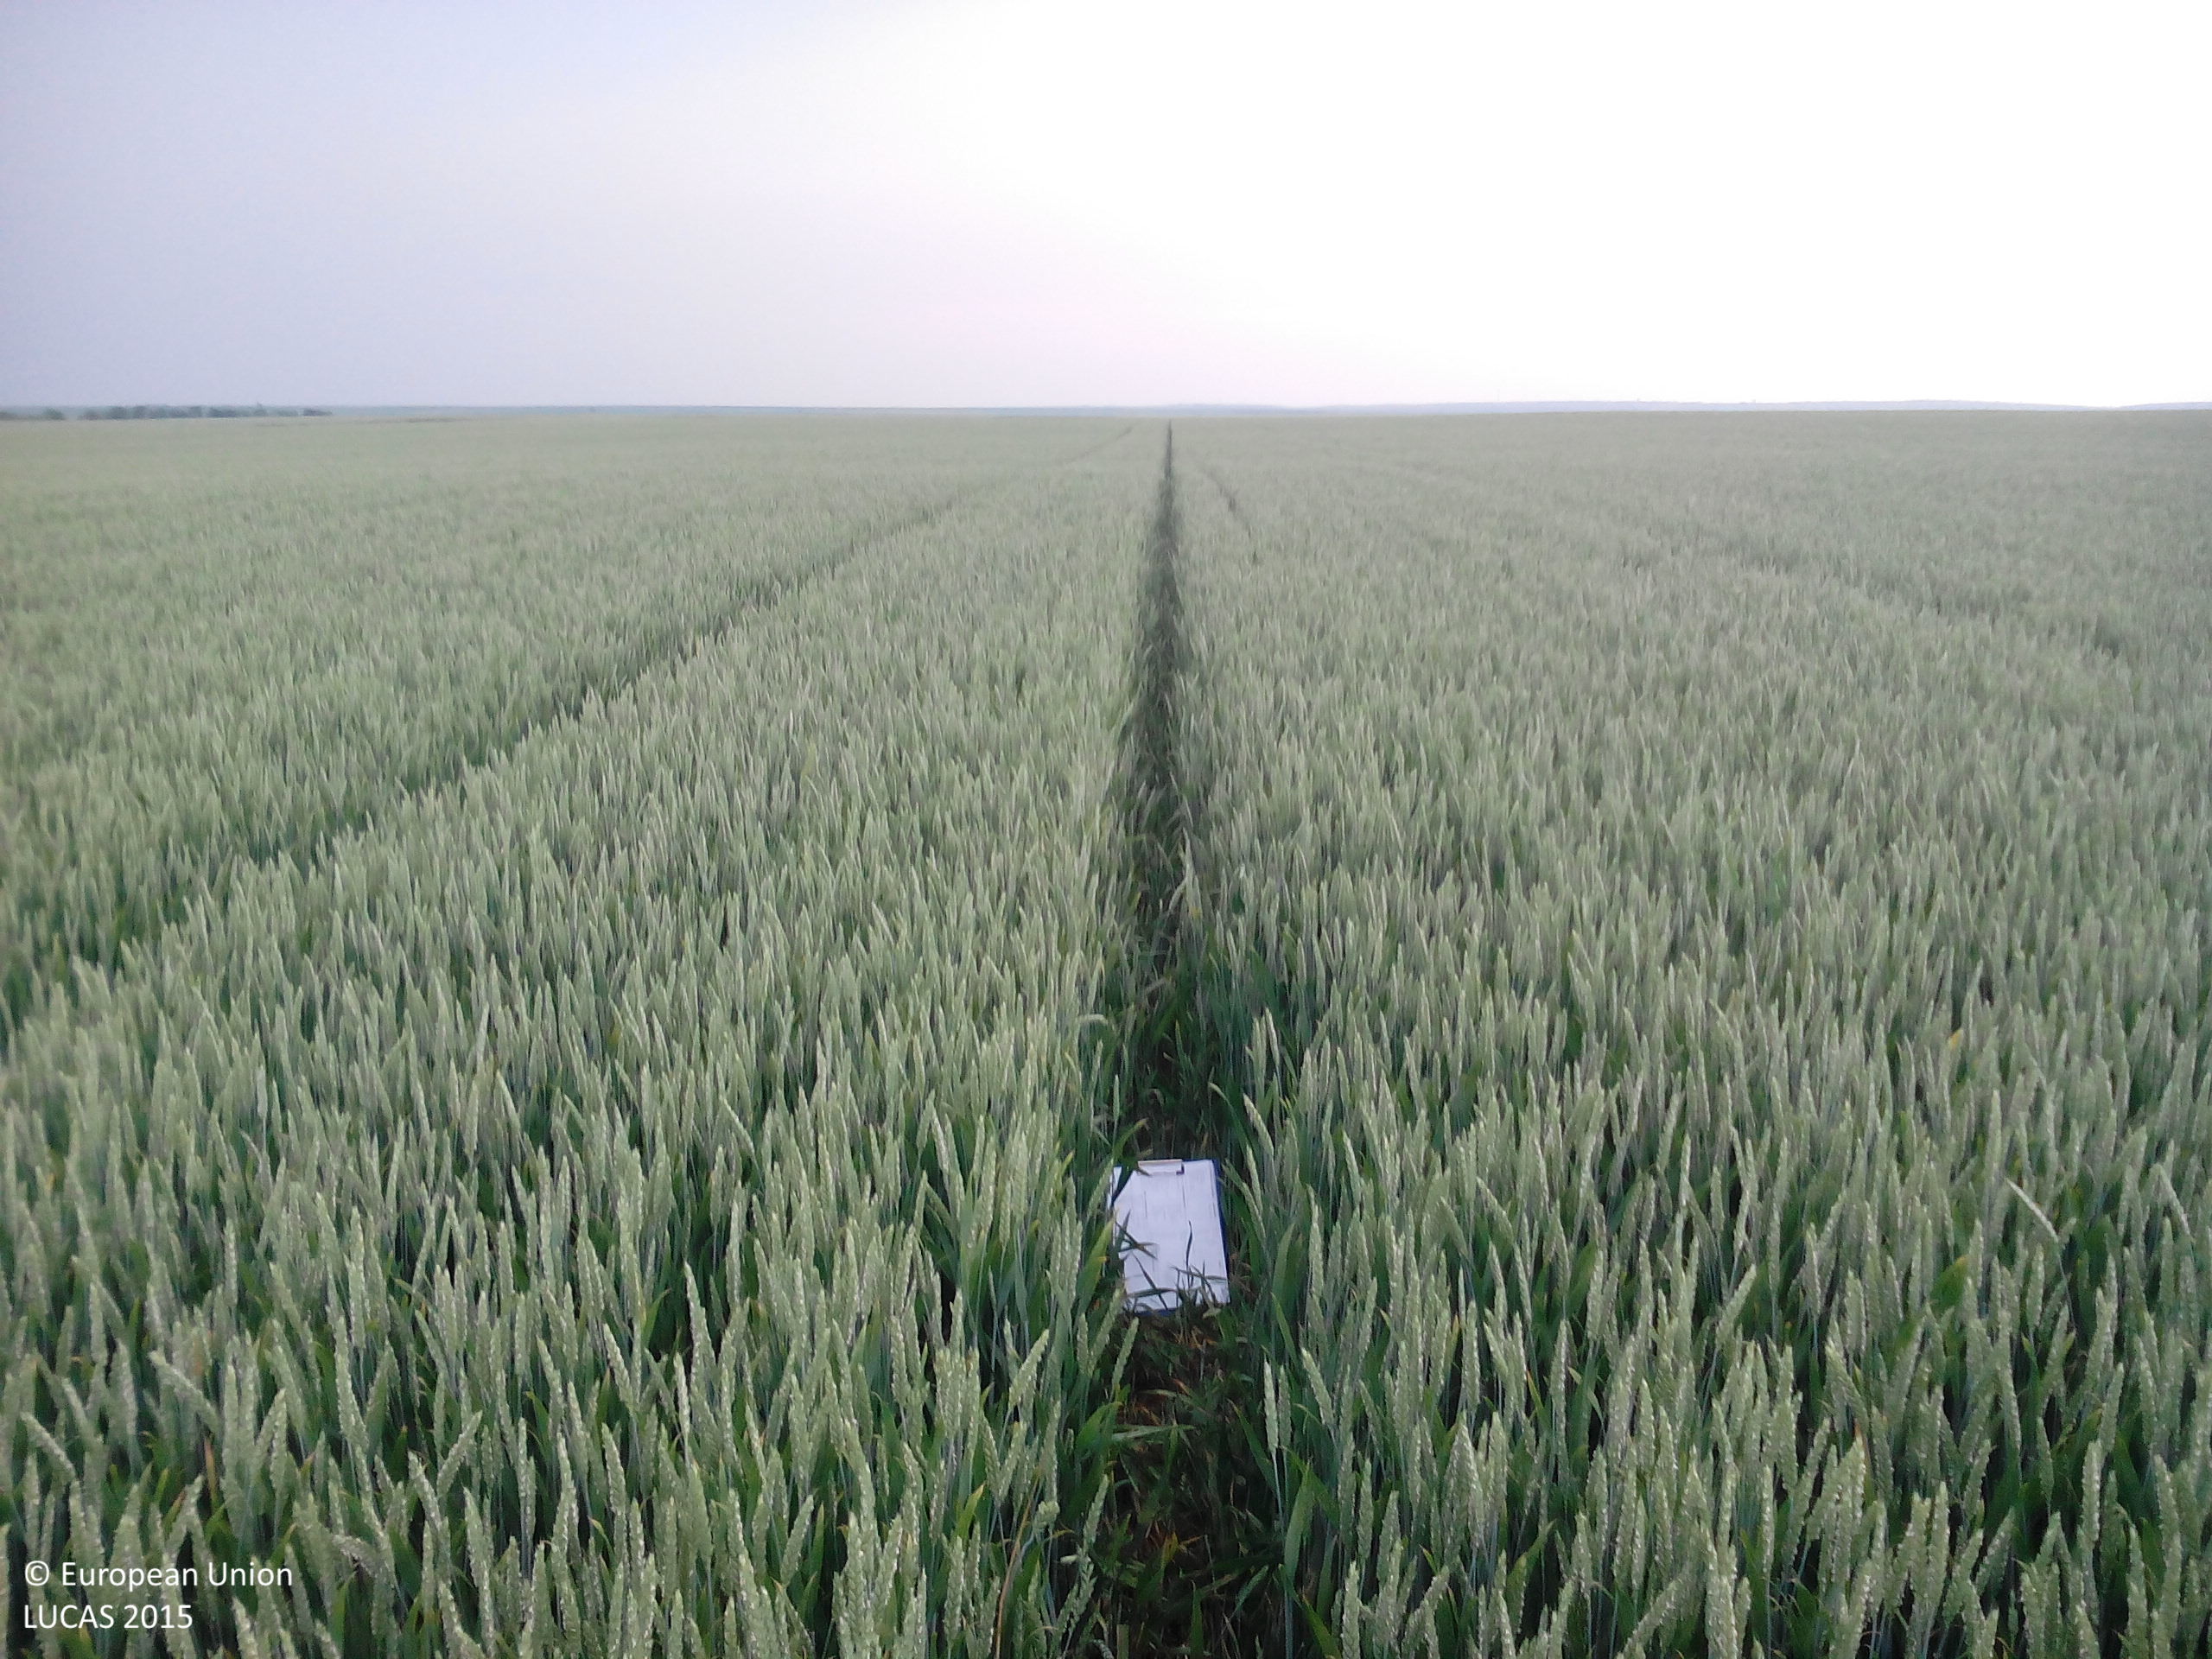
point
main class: Cropland
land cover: Common wheat
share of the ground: > 75 %
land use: Agriculture (excluding fallow land and kitchen gardens)
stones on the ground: < 10 %
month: May
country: BG
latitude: 43.6001
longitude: 24.2422
